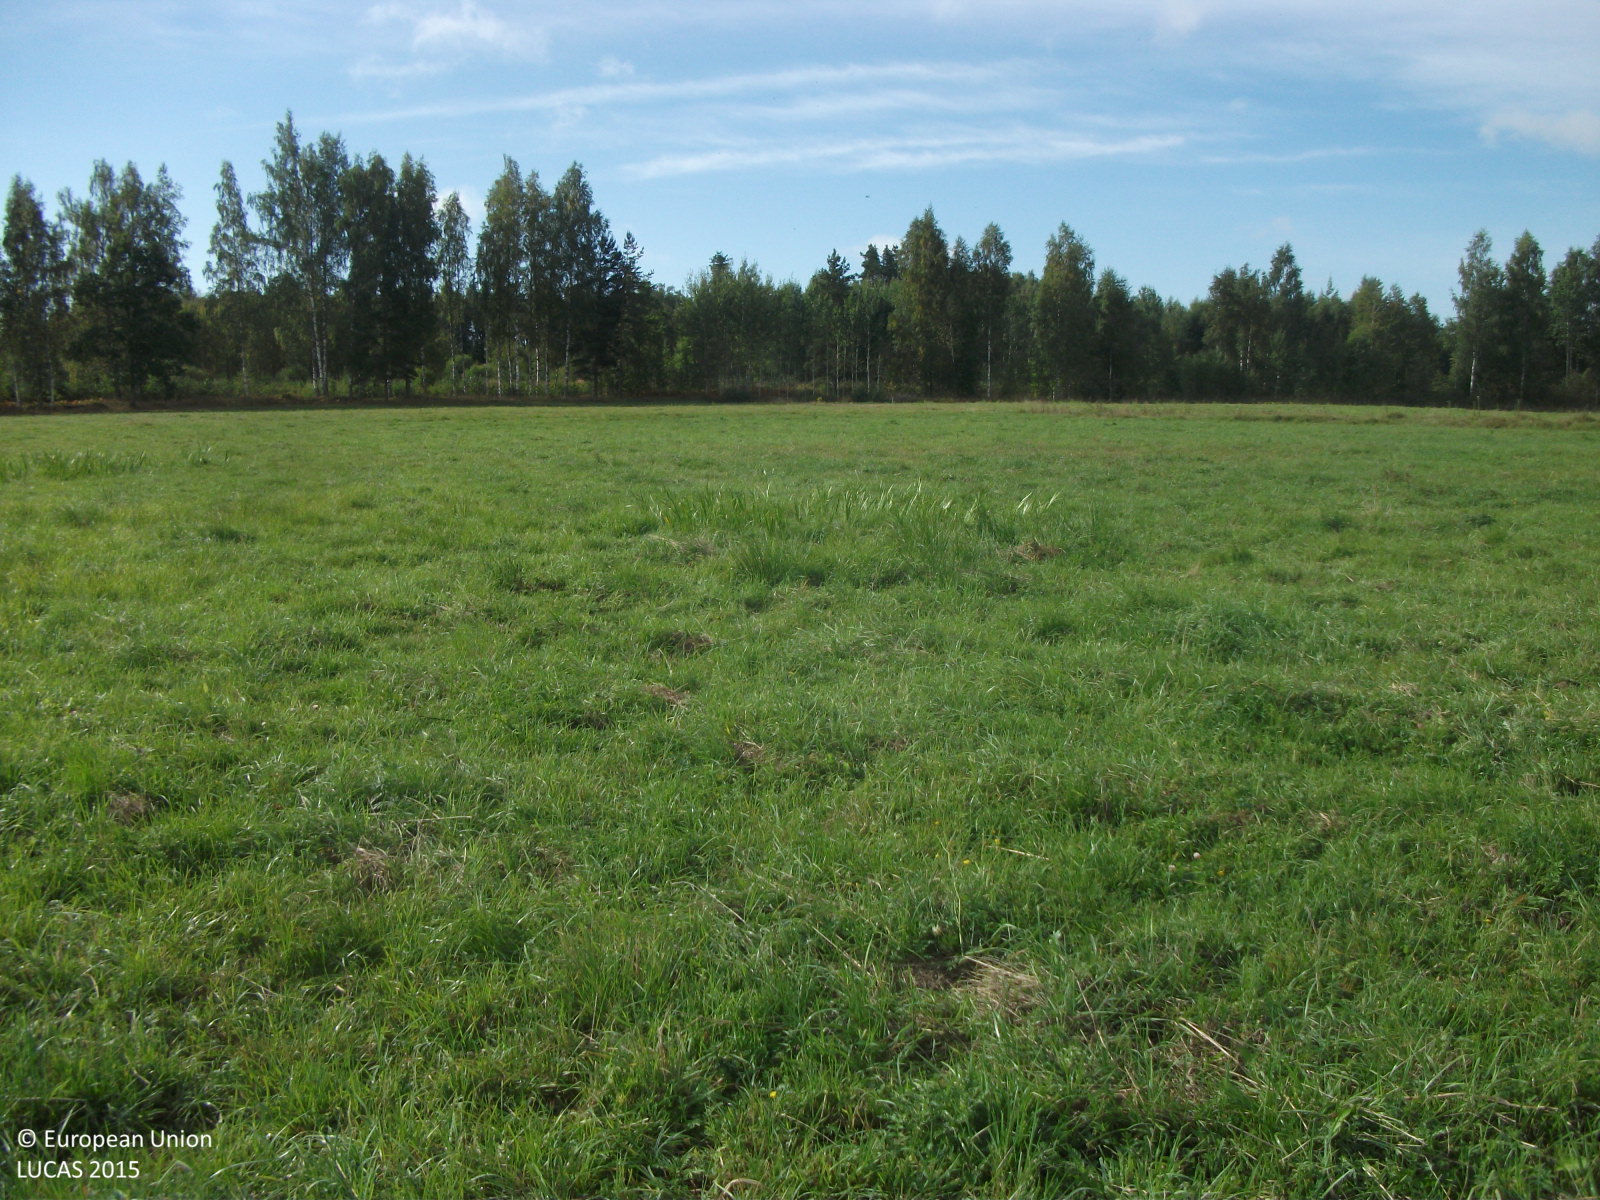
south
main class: Grassland
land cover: Grassland without tree/shrub cover
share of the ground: > 75 %
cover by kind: herbaceous plants 100 %
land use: Agriculture (excluding fallow land and kitchen gardens)
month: September
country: LV
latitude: 56.5425
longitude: 26.2243
